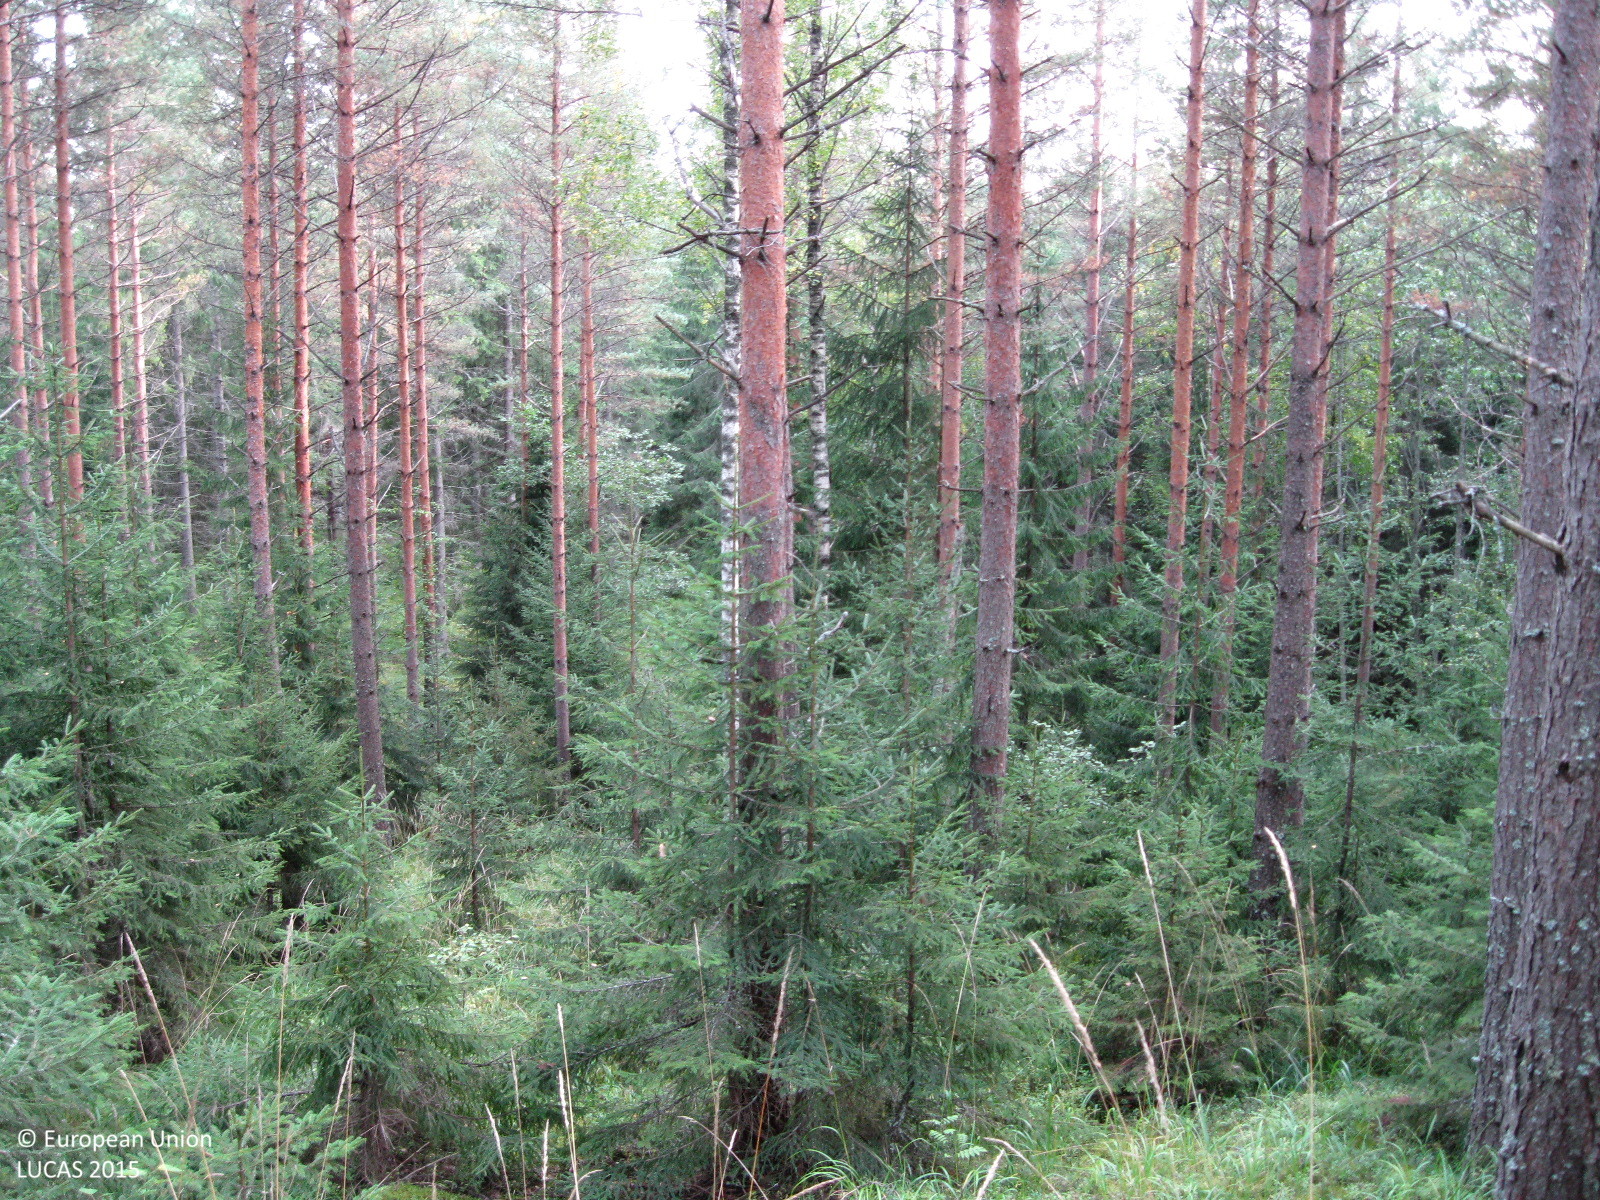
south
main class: Woodland
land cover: Other coniferous woodland
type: boreal forest
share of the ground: 50 - 75 %
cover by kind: coniferous forest trees 60 %, shrubs 15 %, broadleaved forest trees 10 %, lichens and mosses 10 %, herbaceous plants 5 %
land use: Forestry
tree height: > 5 m
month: September
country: FI
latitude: 60.5454
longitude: 24.6764
